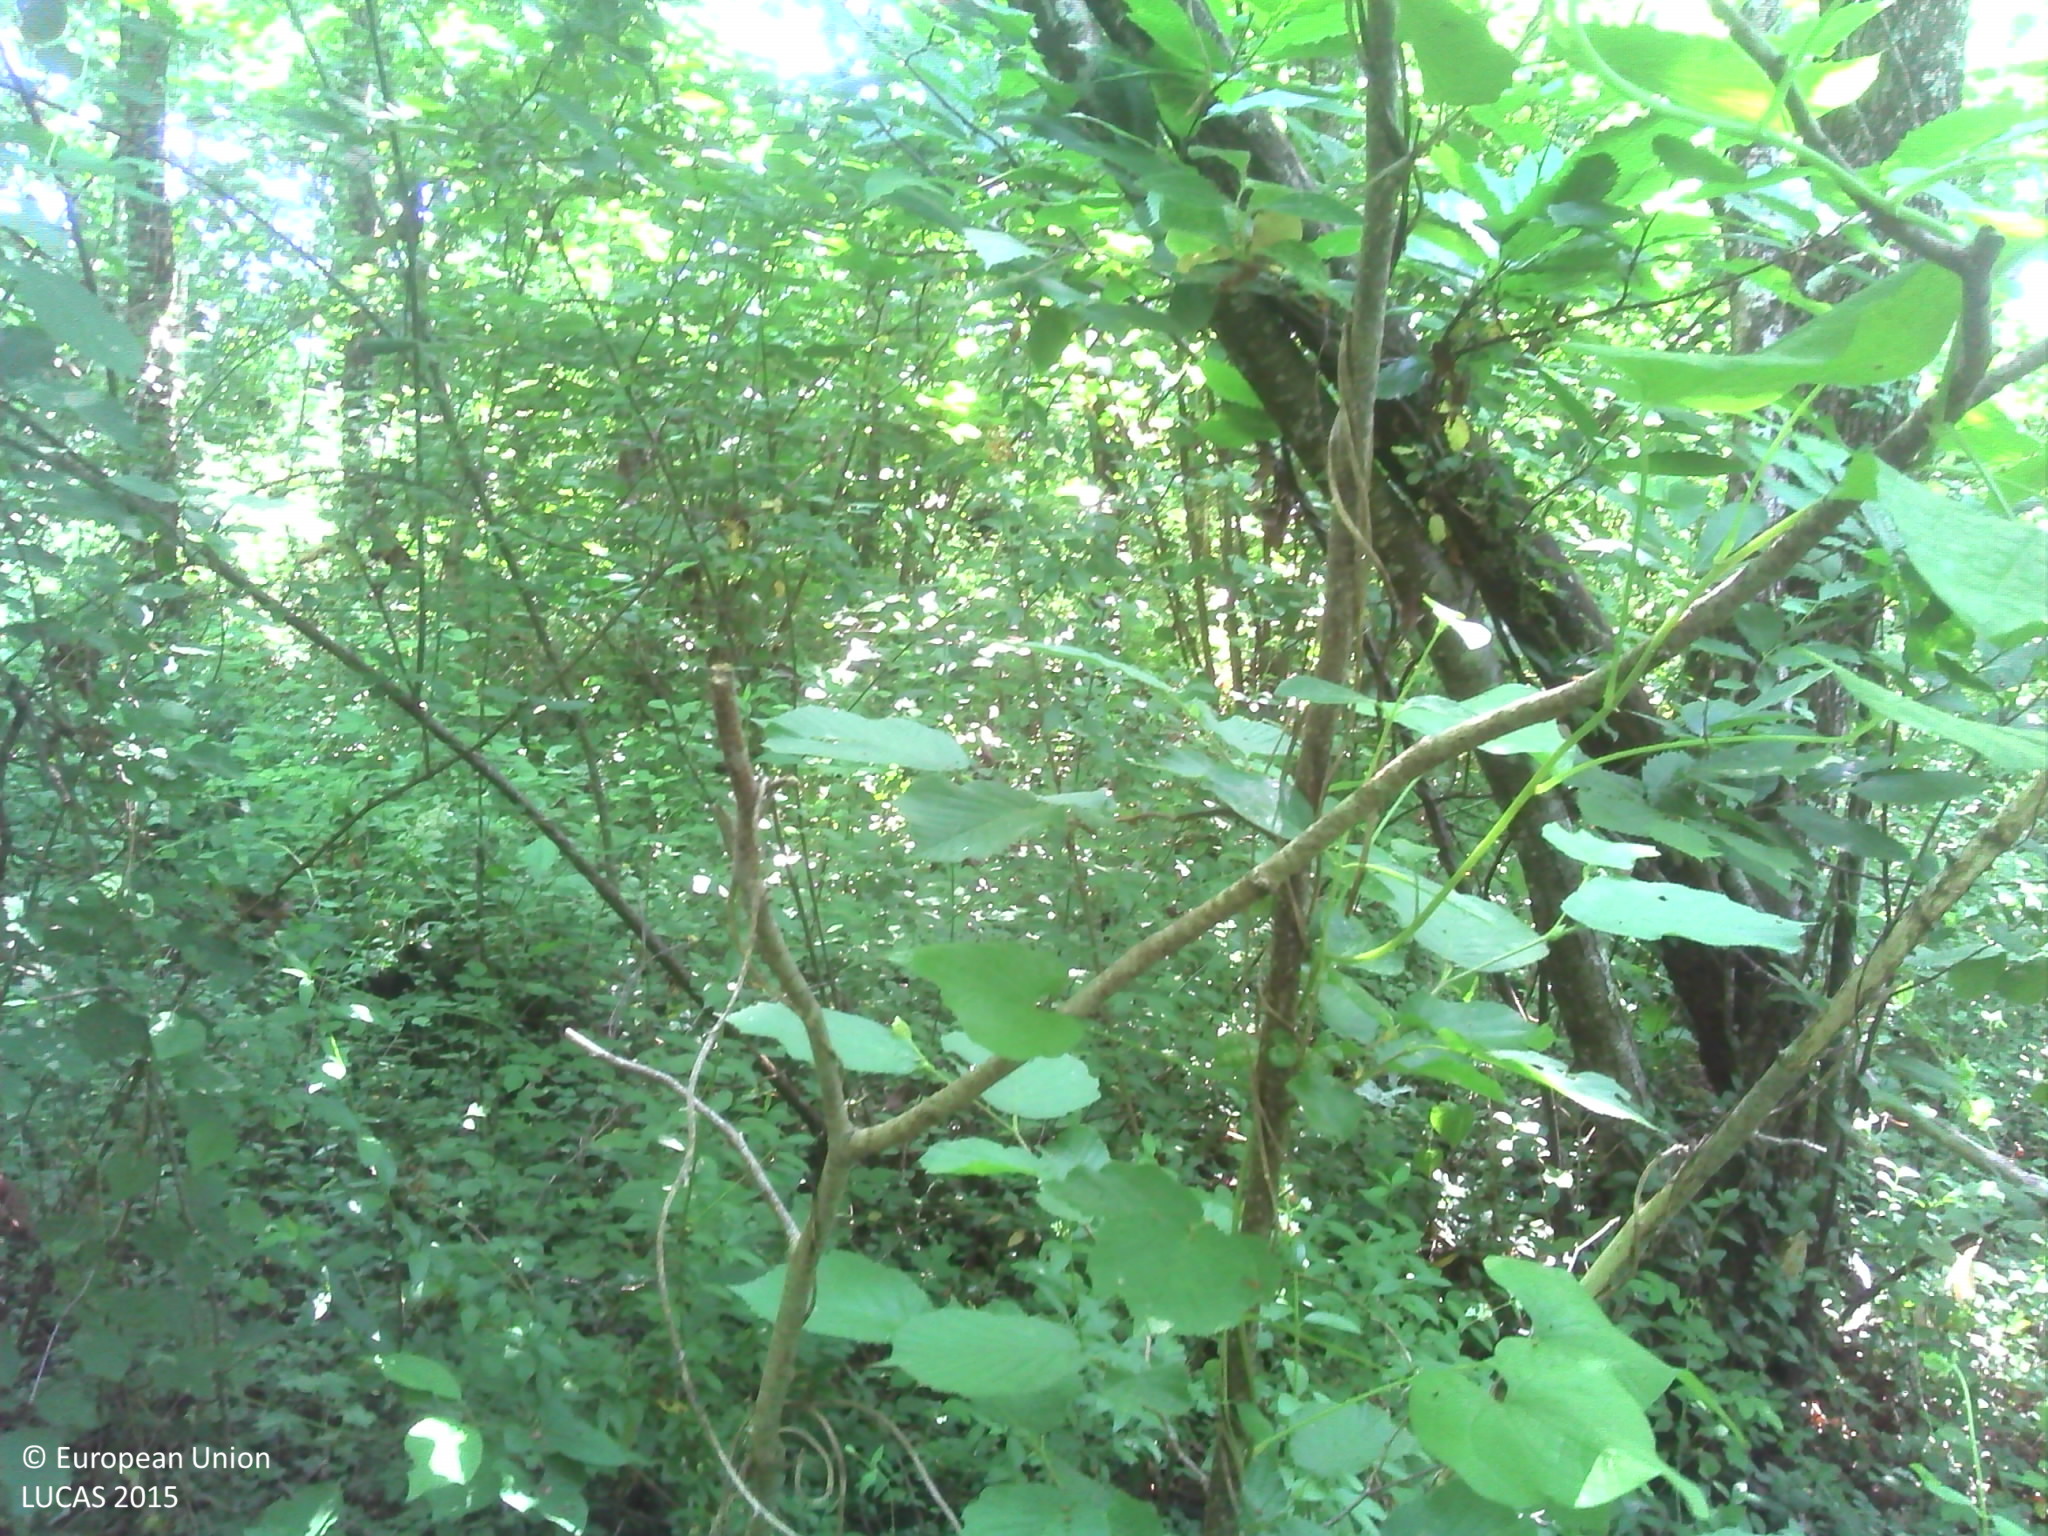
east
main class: Woodland
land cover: Broadleaved woodland
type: mesophytic deciduous forest
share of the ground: > 75 %
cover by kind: broadleaved forest trees 100 %
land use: Forestry
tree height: > 5 m
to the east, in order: Broadleaved woodland; Shrubland without tree cover; Paved roads, cycling and walking lanes; Grass margins; Ditches and canals; Grass margins; Grassland without tree/shrub cover; Vineyards; Grass margins; Ditches and canals; Grassland without tree/shrub cover
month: June
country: FR
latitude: 43.8566
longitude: 1.9542
